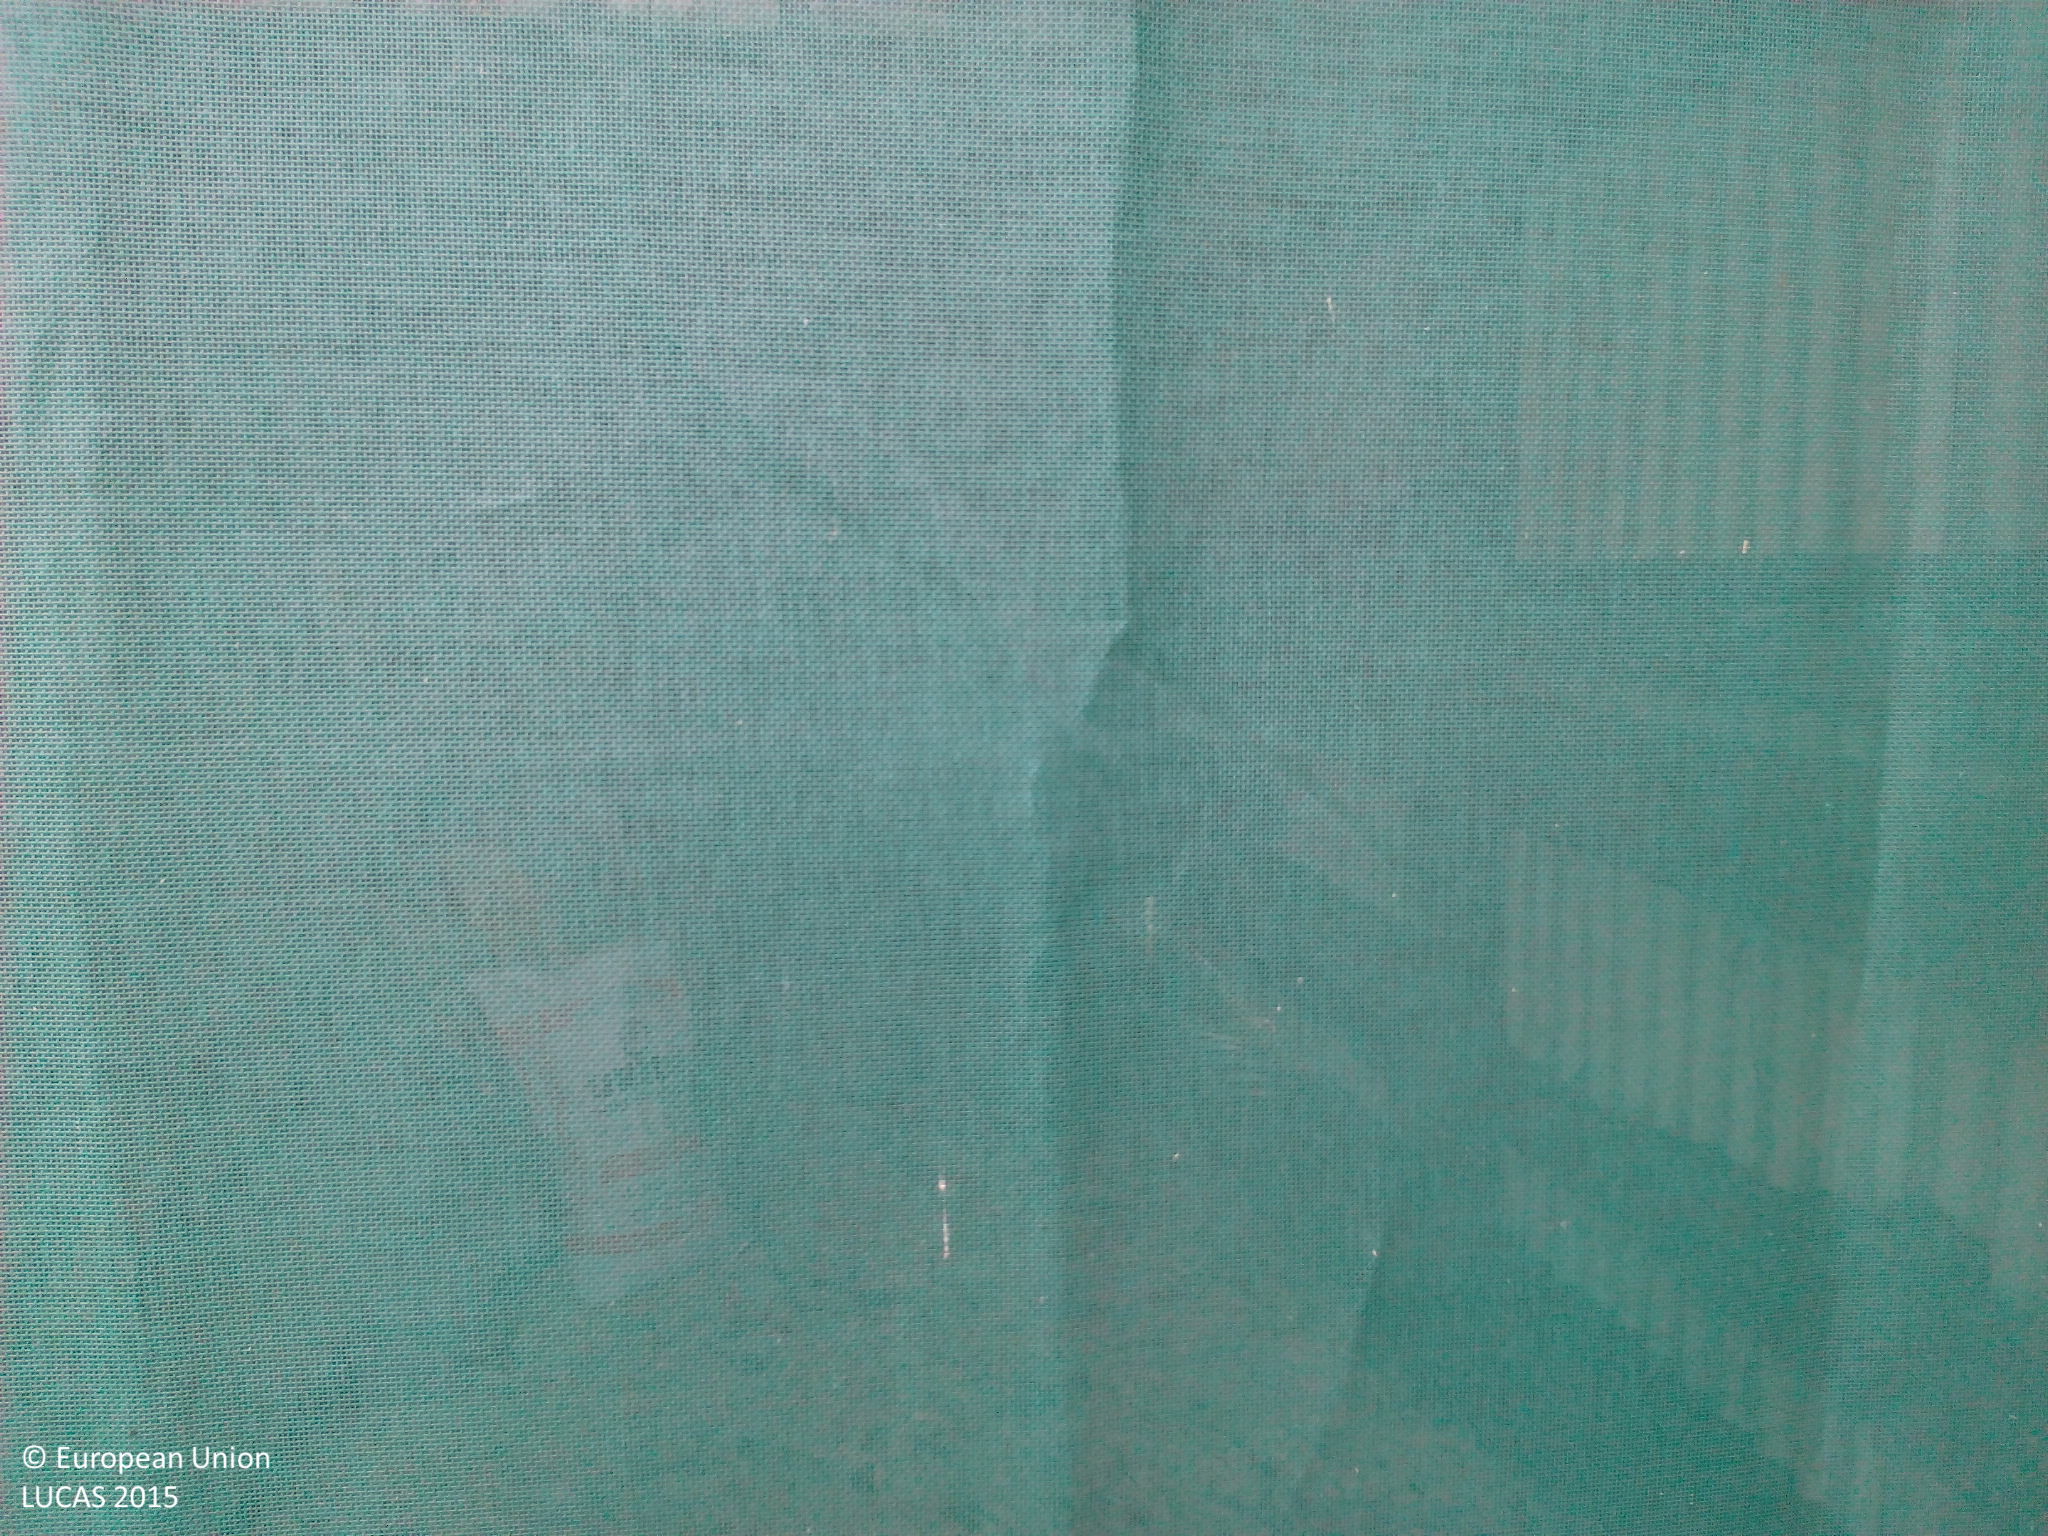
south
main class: Grassland
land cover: Grassland without tree/shrub cover
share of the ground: > 75 %
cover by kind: herbaceous plants 100 %
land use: Agriculture (excluding fallow land and kitchen gardens)
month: August
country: DE
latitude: 48.6554
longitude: 9.9593
